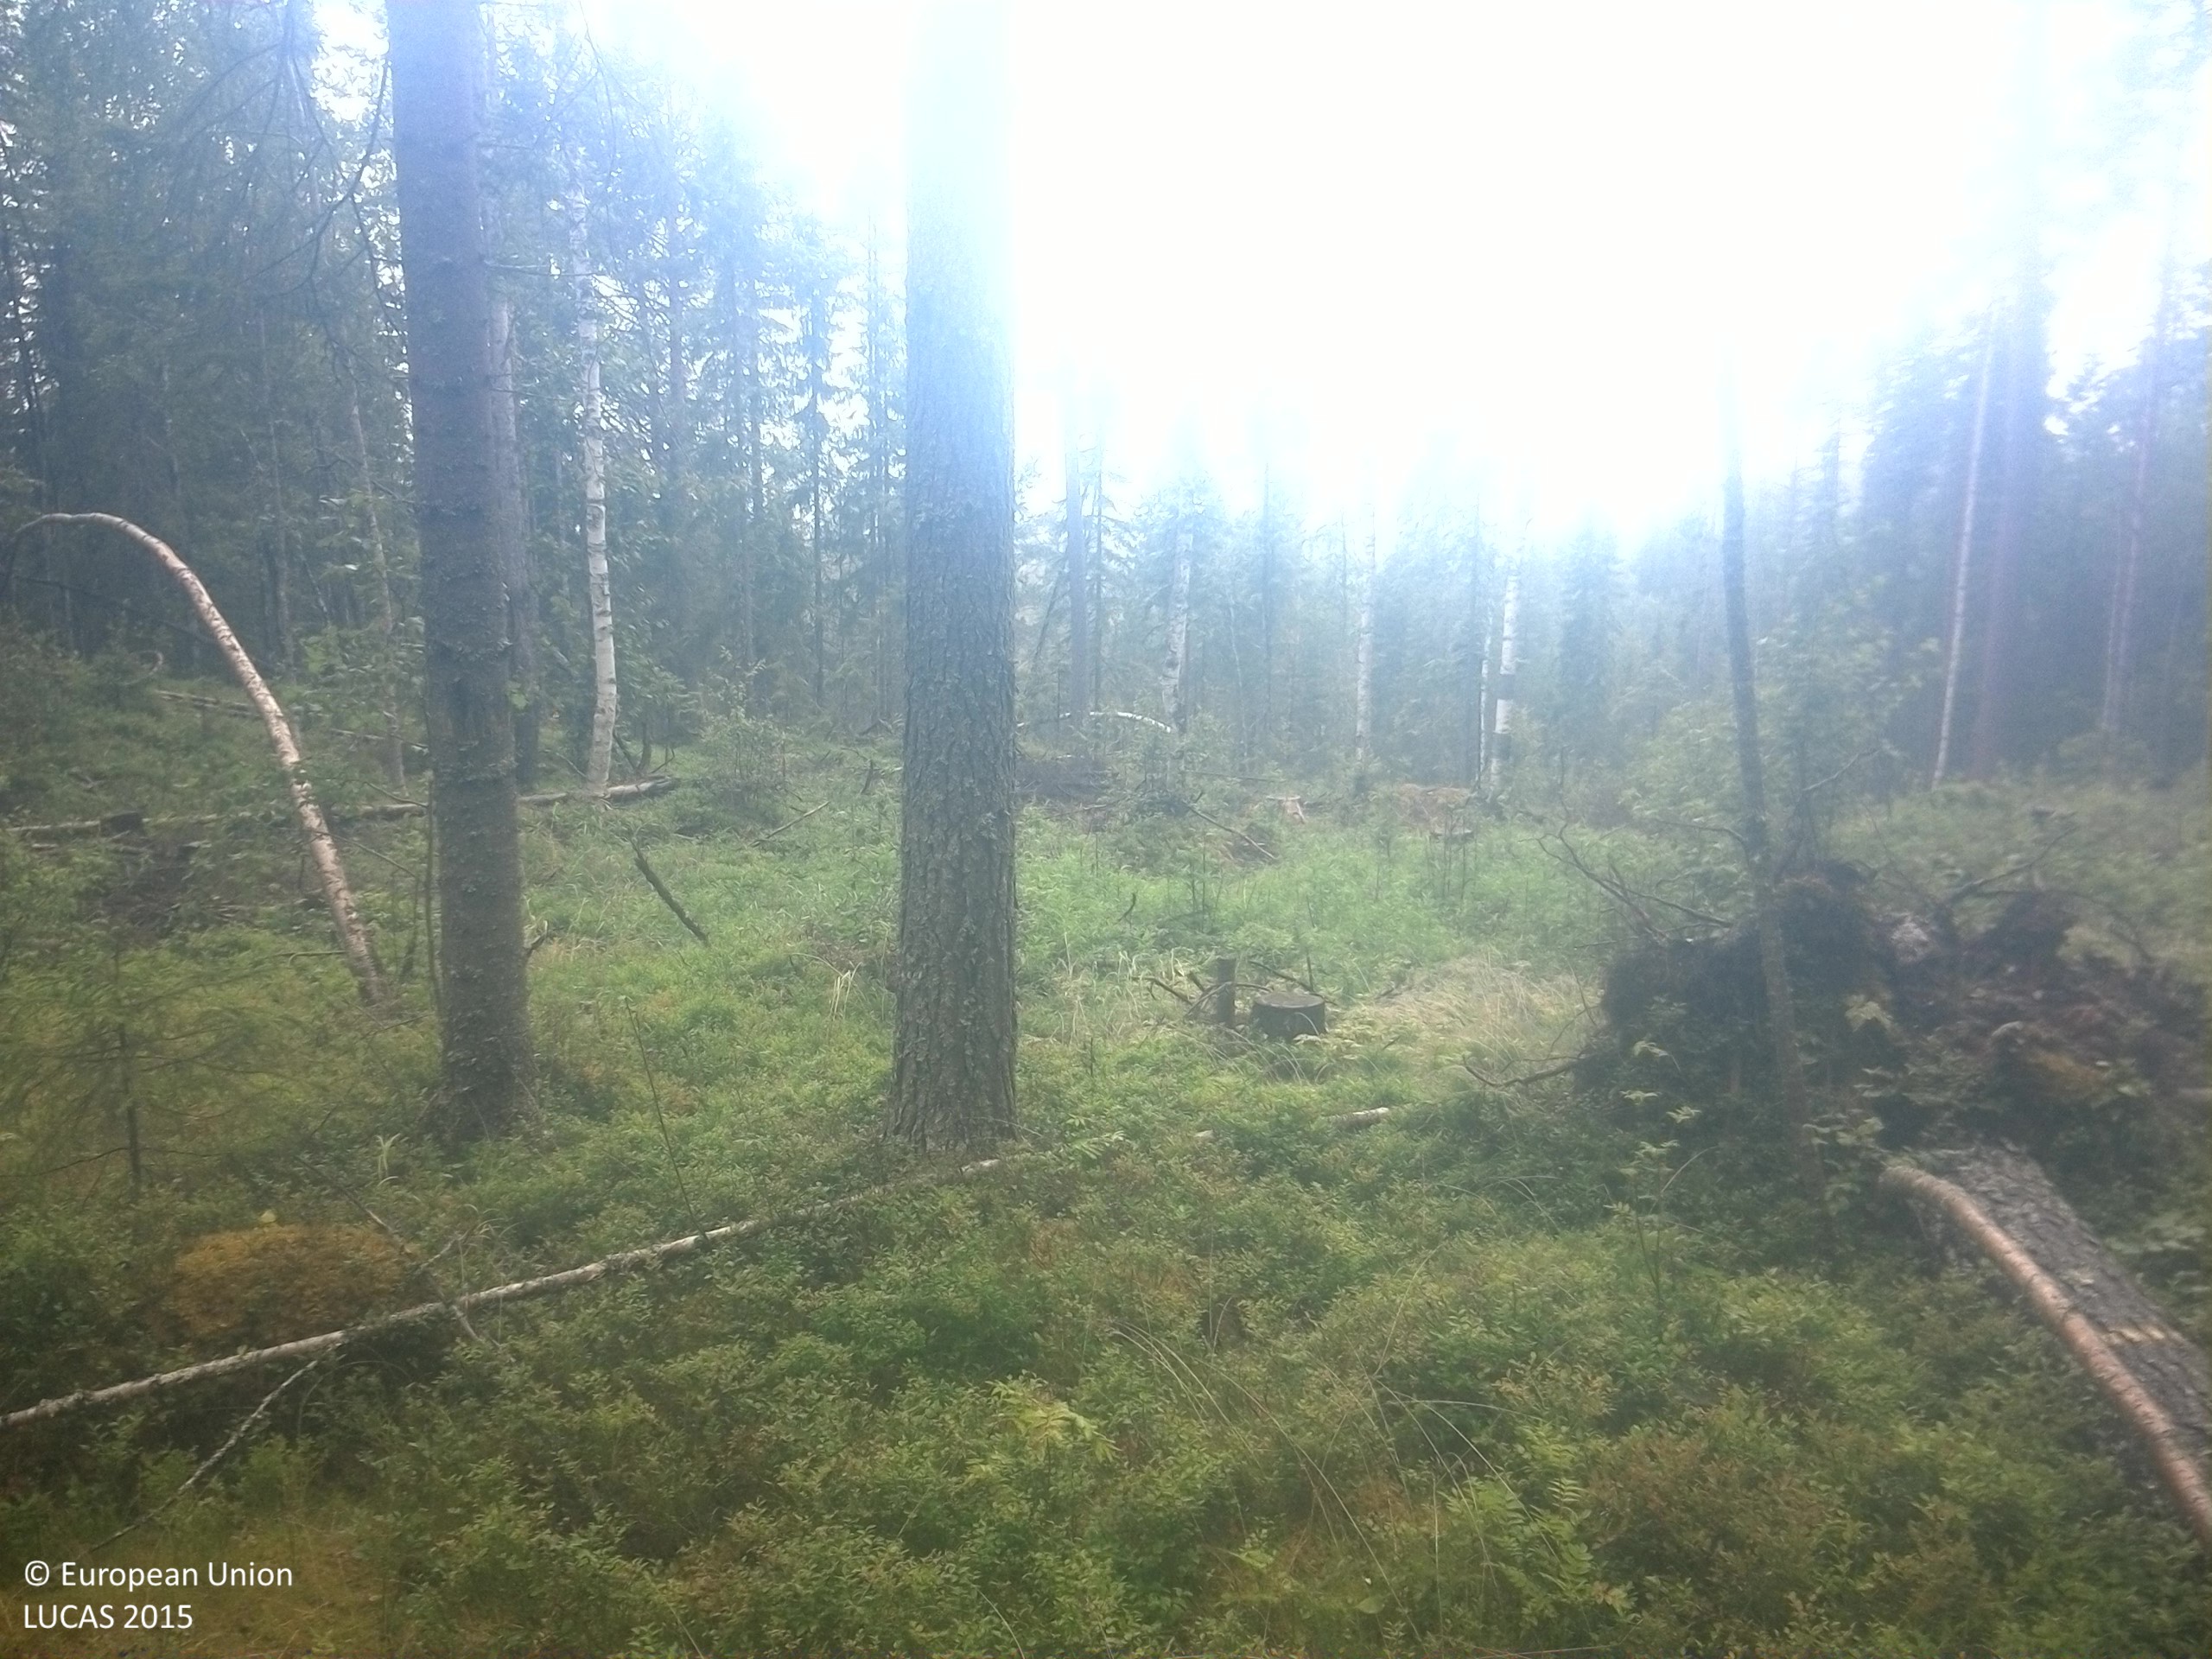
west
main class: Woodland
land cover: Other coniferous woodland
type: boreal forest
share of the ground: 25 - 50 %
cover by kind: coniferous forest trees 40 %, shrubs 40 %, lichens and mosses 10 %, broadleaved forest trees 5 %, herbaceous plants 5 %
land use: Forestry
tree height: > 5 m
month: August
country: SE
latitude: 63.5790
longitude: 16.4394
